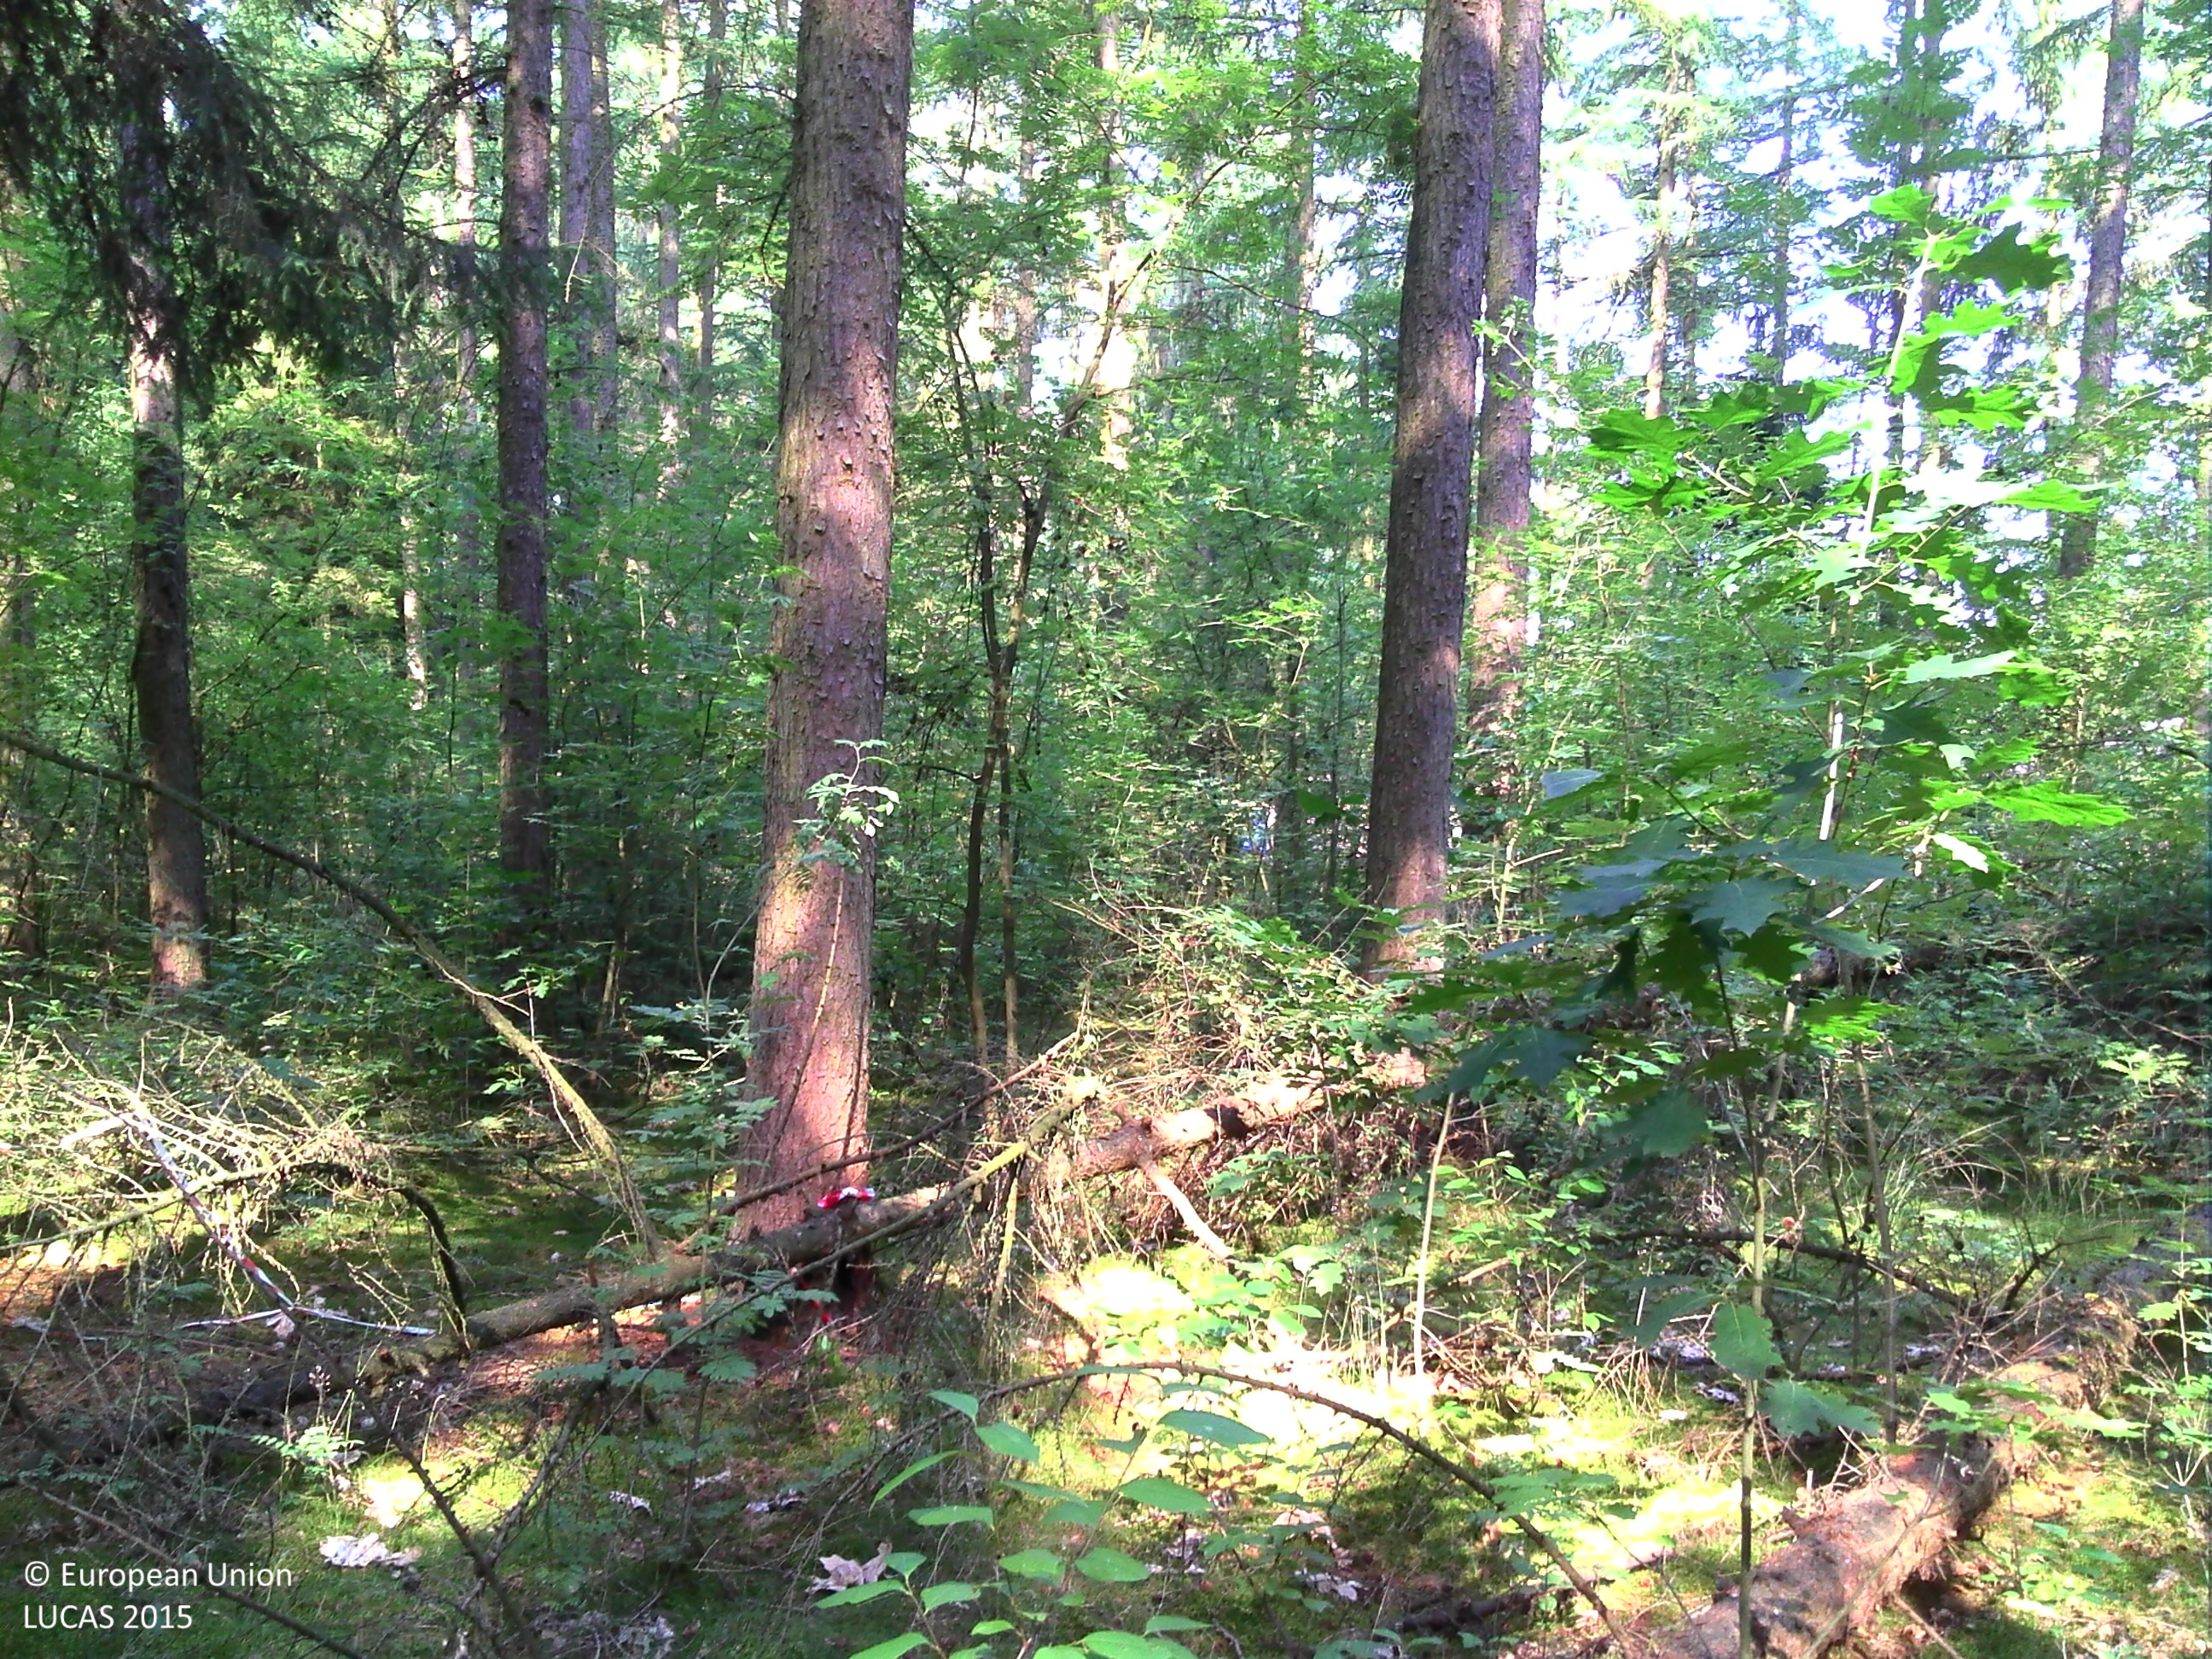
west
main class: Woodland
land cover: Other mixed woodland
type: exotic forest
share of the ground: > 75 %
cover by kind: coniferous forest trees 70 %, broadleaved forest trees 25 %, lichens and mosses 5 %
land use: Forestry
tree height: > 5 m
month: July
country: BE
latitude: 50.9750
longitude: 5.4263
